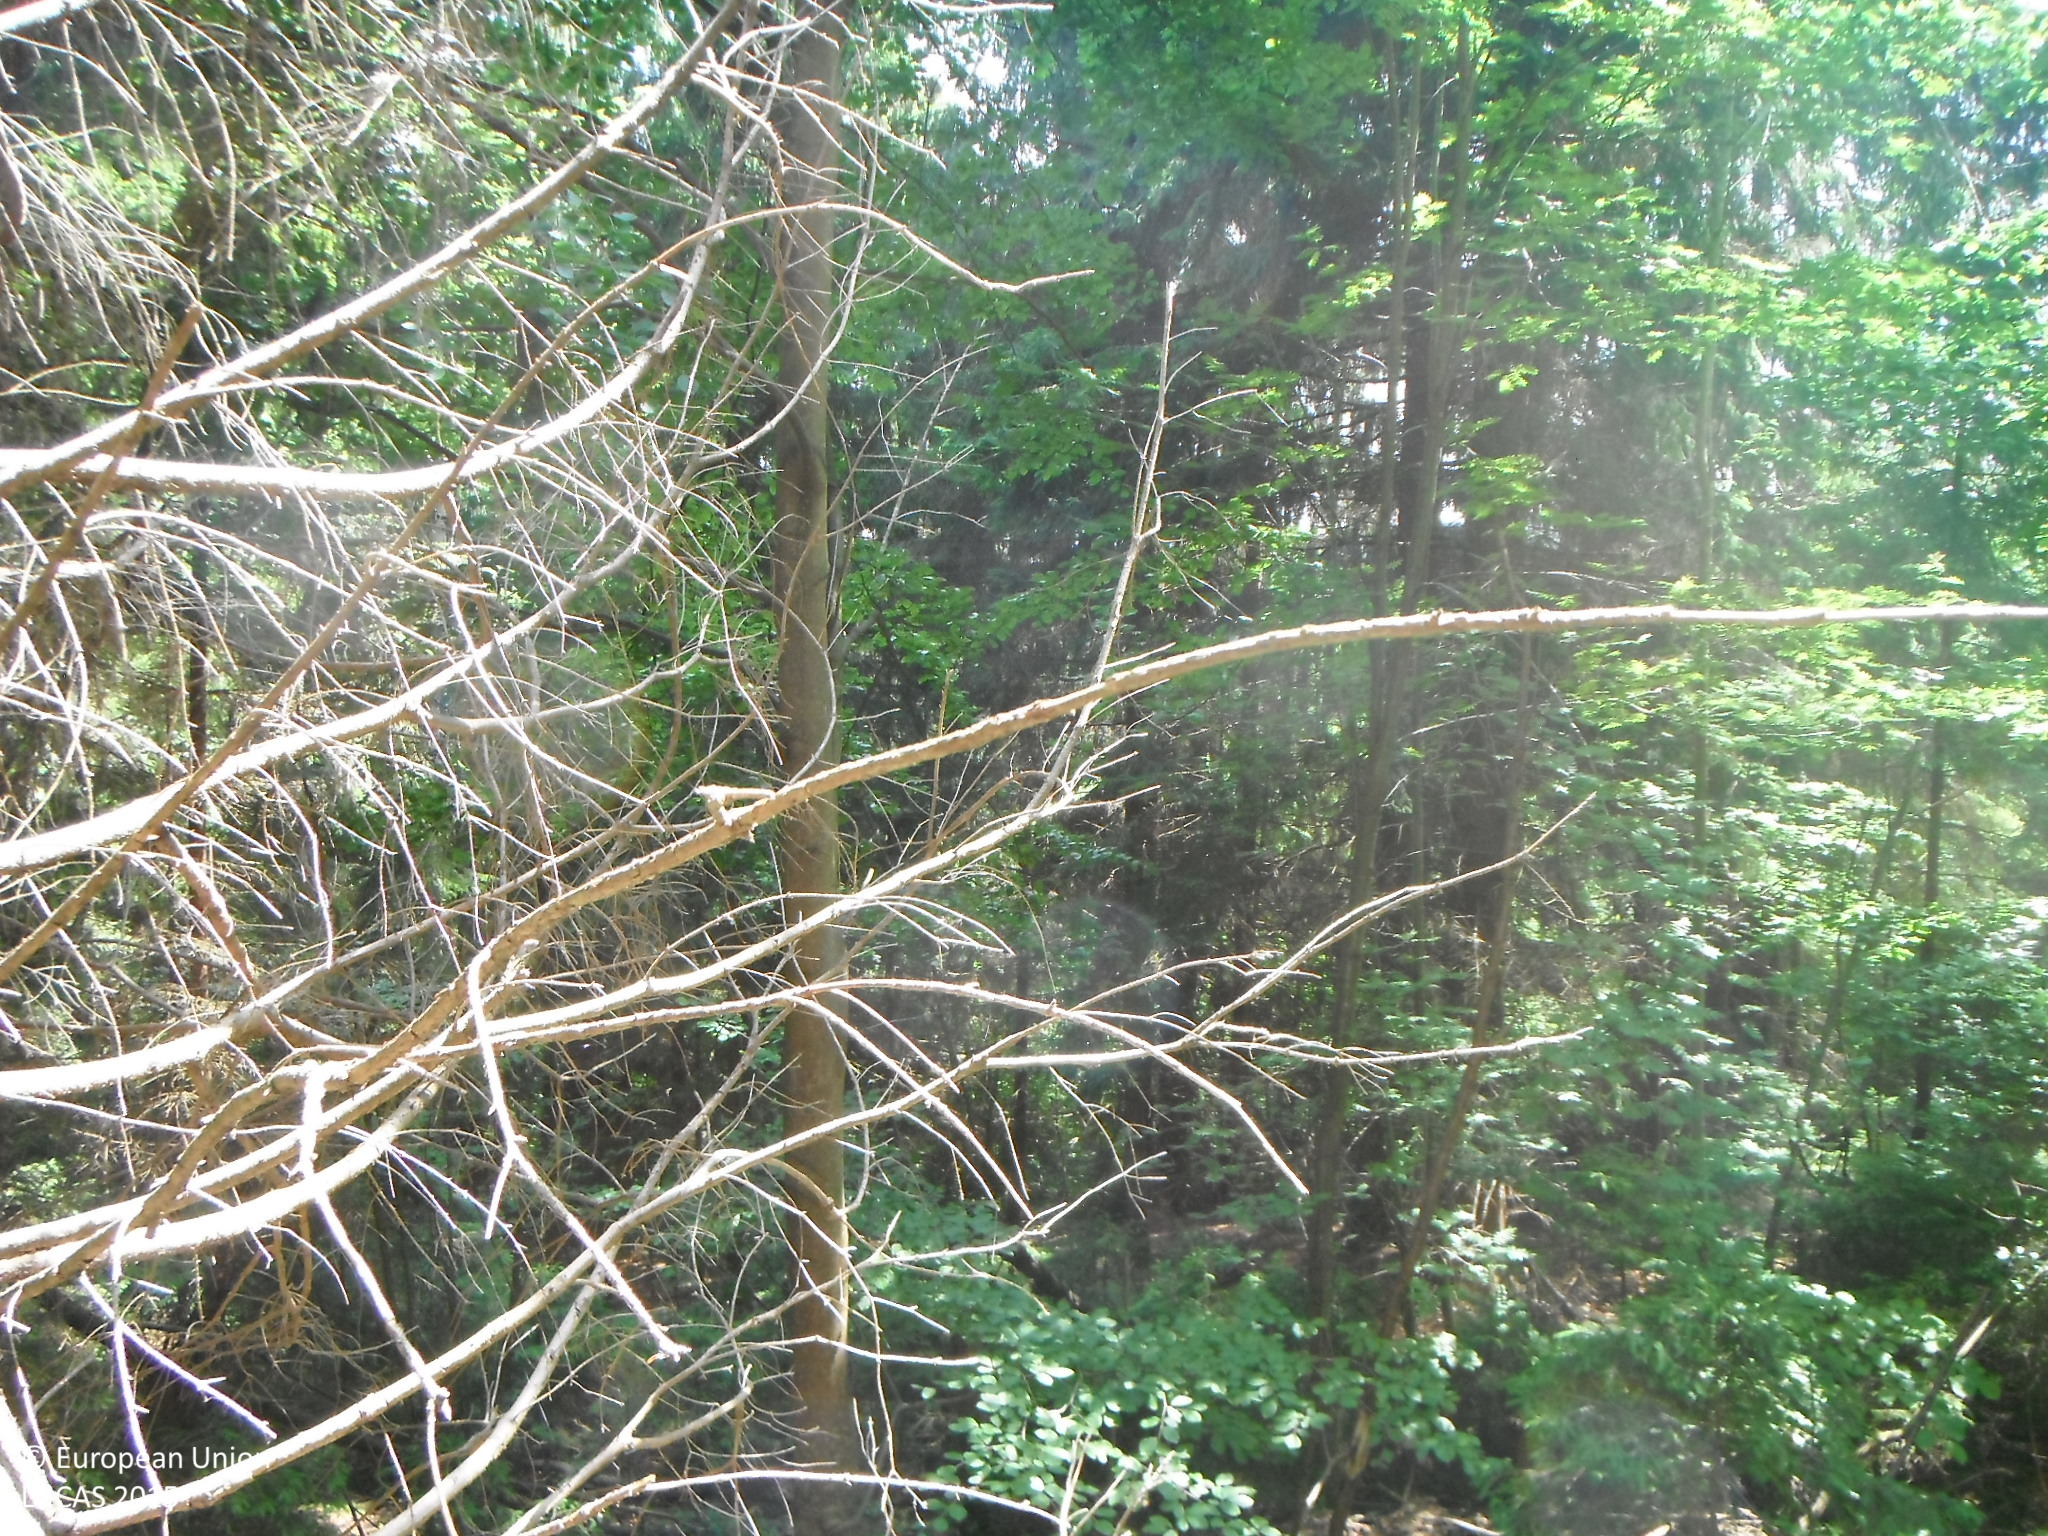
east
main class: Woodland
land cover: Spruce dominated mixed woodland
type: hemiboreal forest and nemoral coniferous forest and mixed broadleaved-coniferous forest
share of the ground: > 75 %
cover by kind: coniferous forest trees 65 %, broadleaved forest trees 25 %, herbaceous plants 10 %
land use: Forestry
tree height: > 5 m
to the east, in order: Spruce dominated mixed woodland; Broadleaved woodland; Spontaneously vegetated surfaces; Spruce dominated mixed woodland; Spontaneously vegetated surfaces; Spruce dominated coniferous woodland
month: June
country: SK
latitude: 49.2621
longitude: 19.4940
